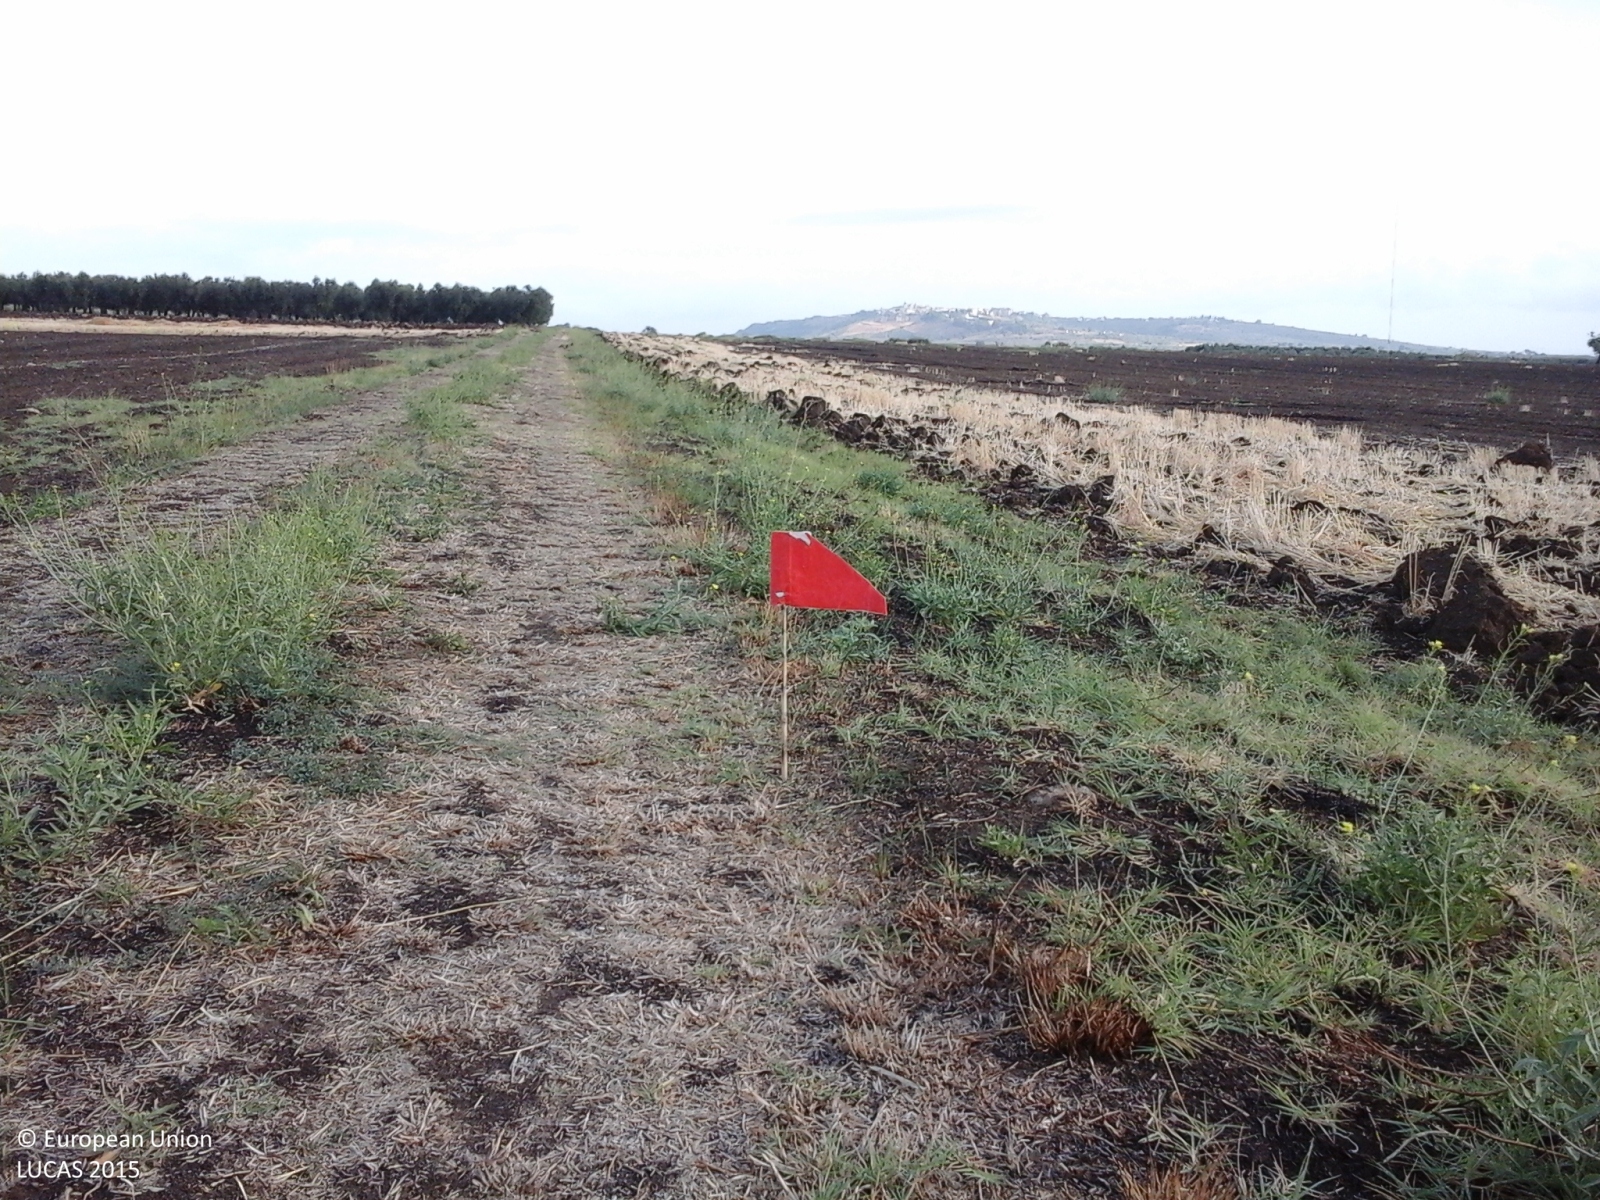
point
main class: Cropland
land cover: Durum wheat
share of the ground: > 75 %
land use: Agriculture (excluding fallow land and kitchen gardens)
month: September
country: IT
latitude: 41.7631
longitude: 15.1438
